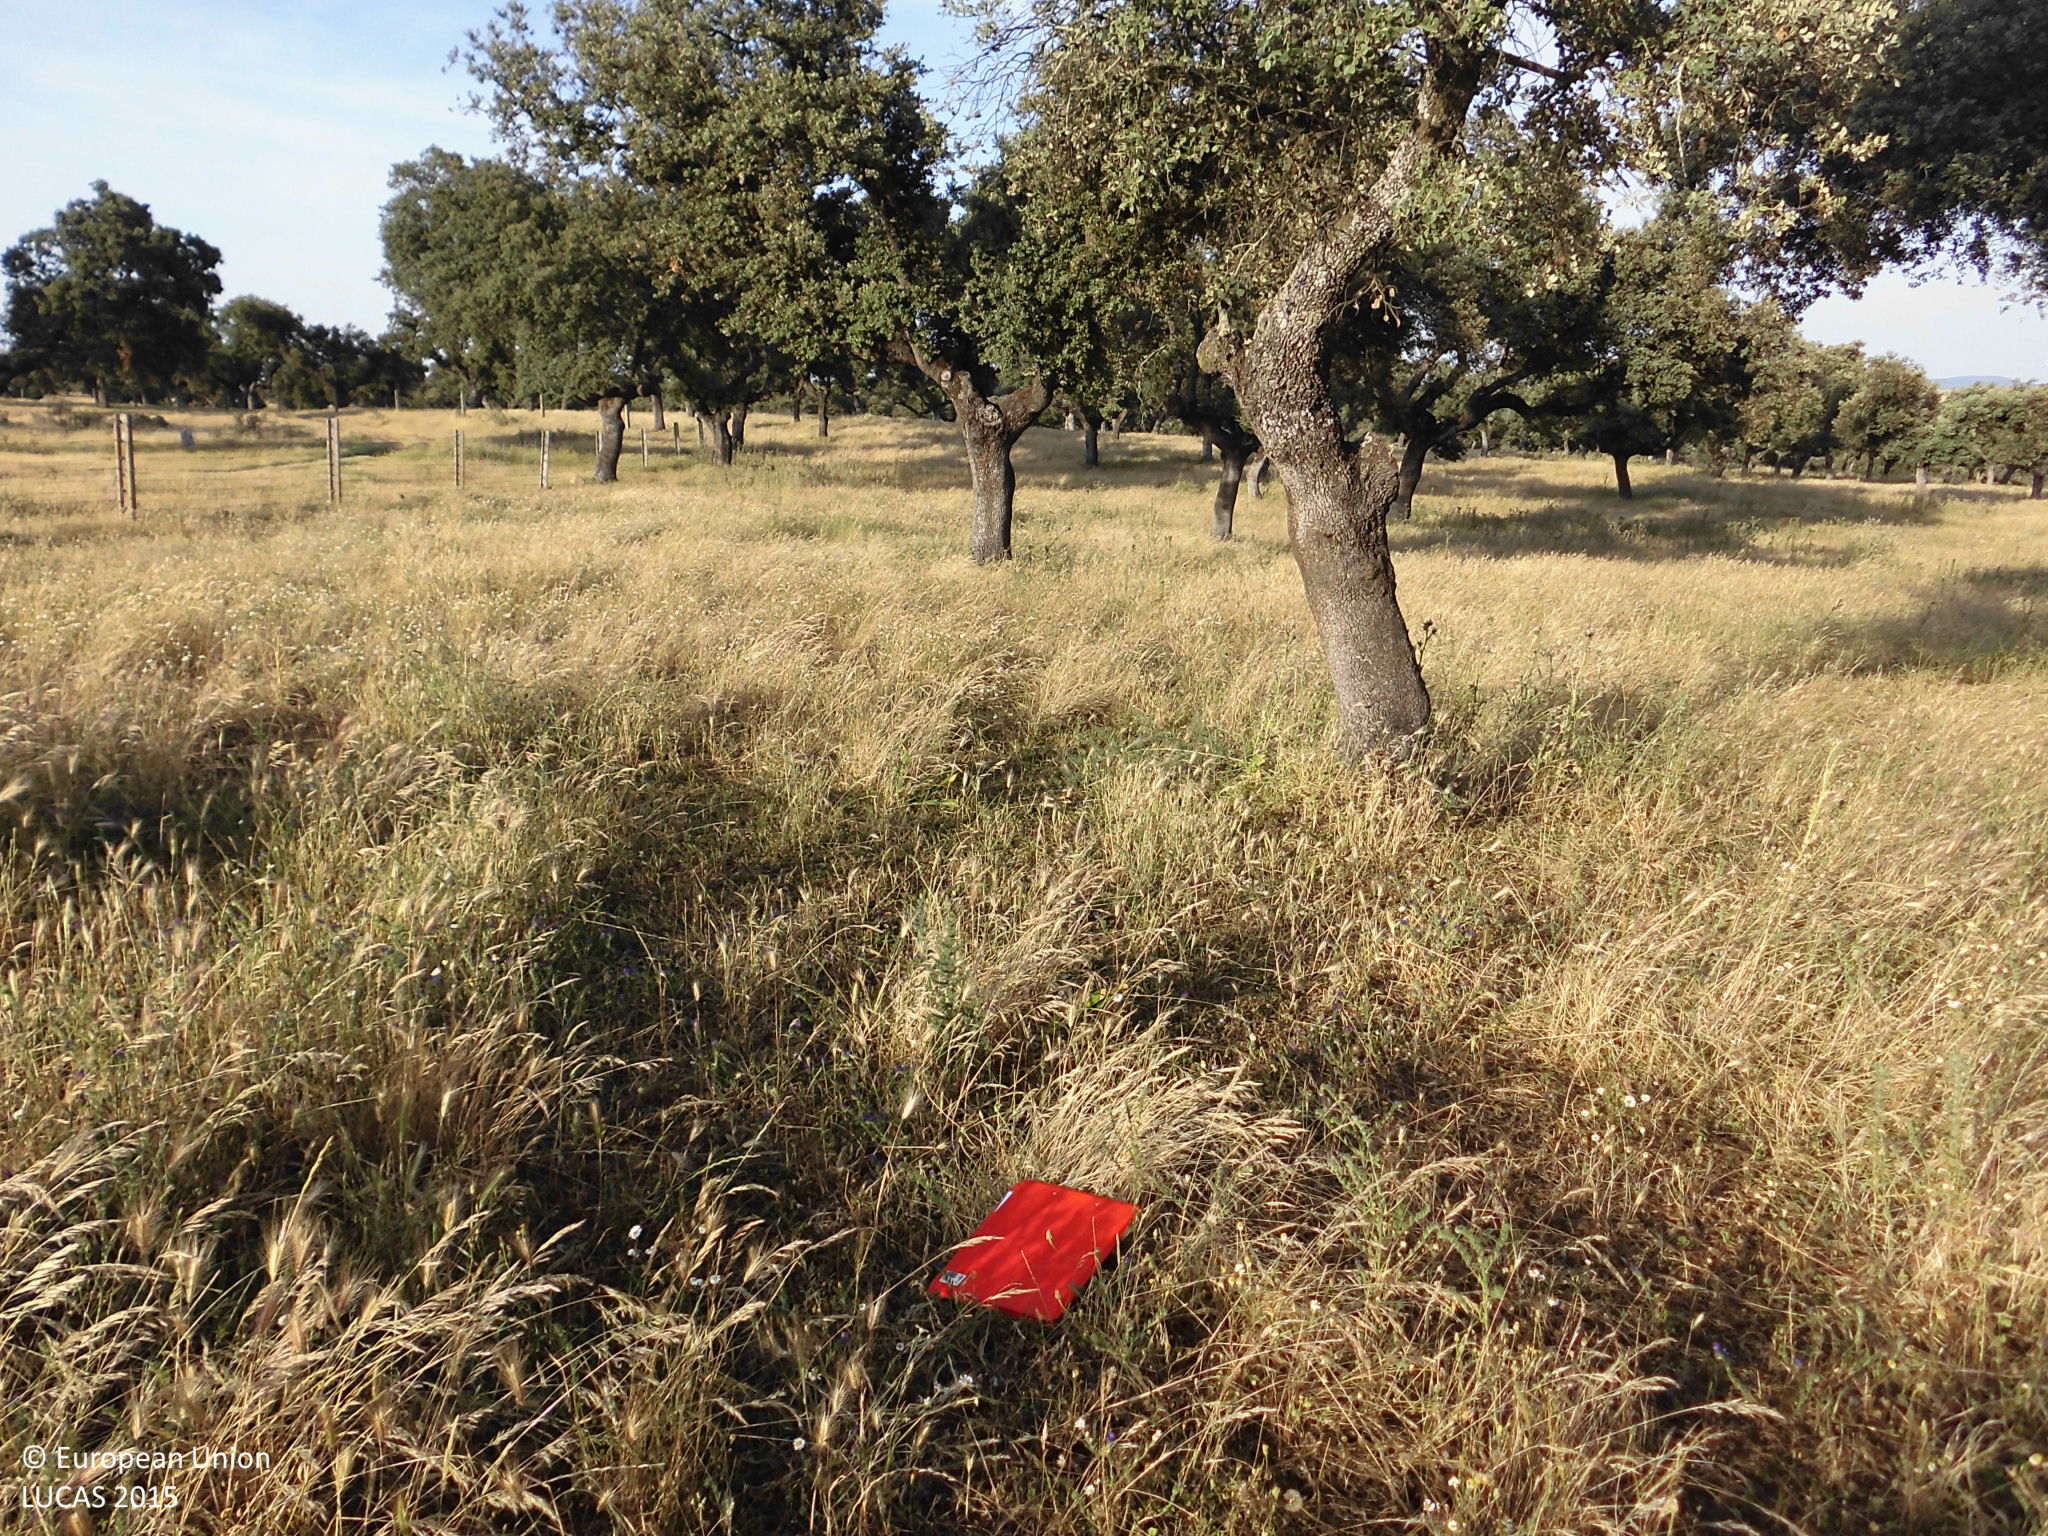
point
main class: Woodland
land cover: Broadleaved woodland
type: broadleaved evergreen forest
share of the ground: 25 - 50 %
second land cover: Grassland without tree/shrub cover
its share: > 75 %
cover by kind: herbaceous plants 60 %, broadleaved forest trees 40 %
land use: Forestry
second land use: Agriculture (excluding fallow land and kitchen gardens)
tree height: > 5 m
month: May
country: ES
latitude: 39.3687
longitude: -5.9954
